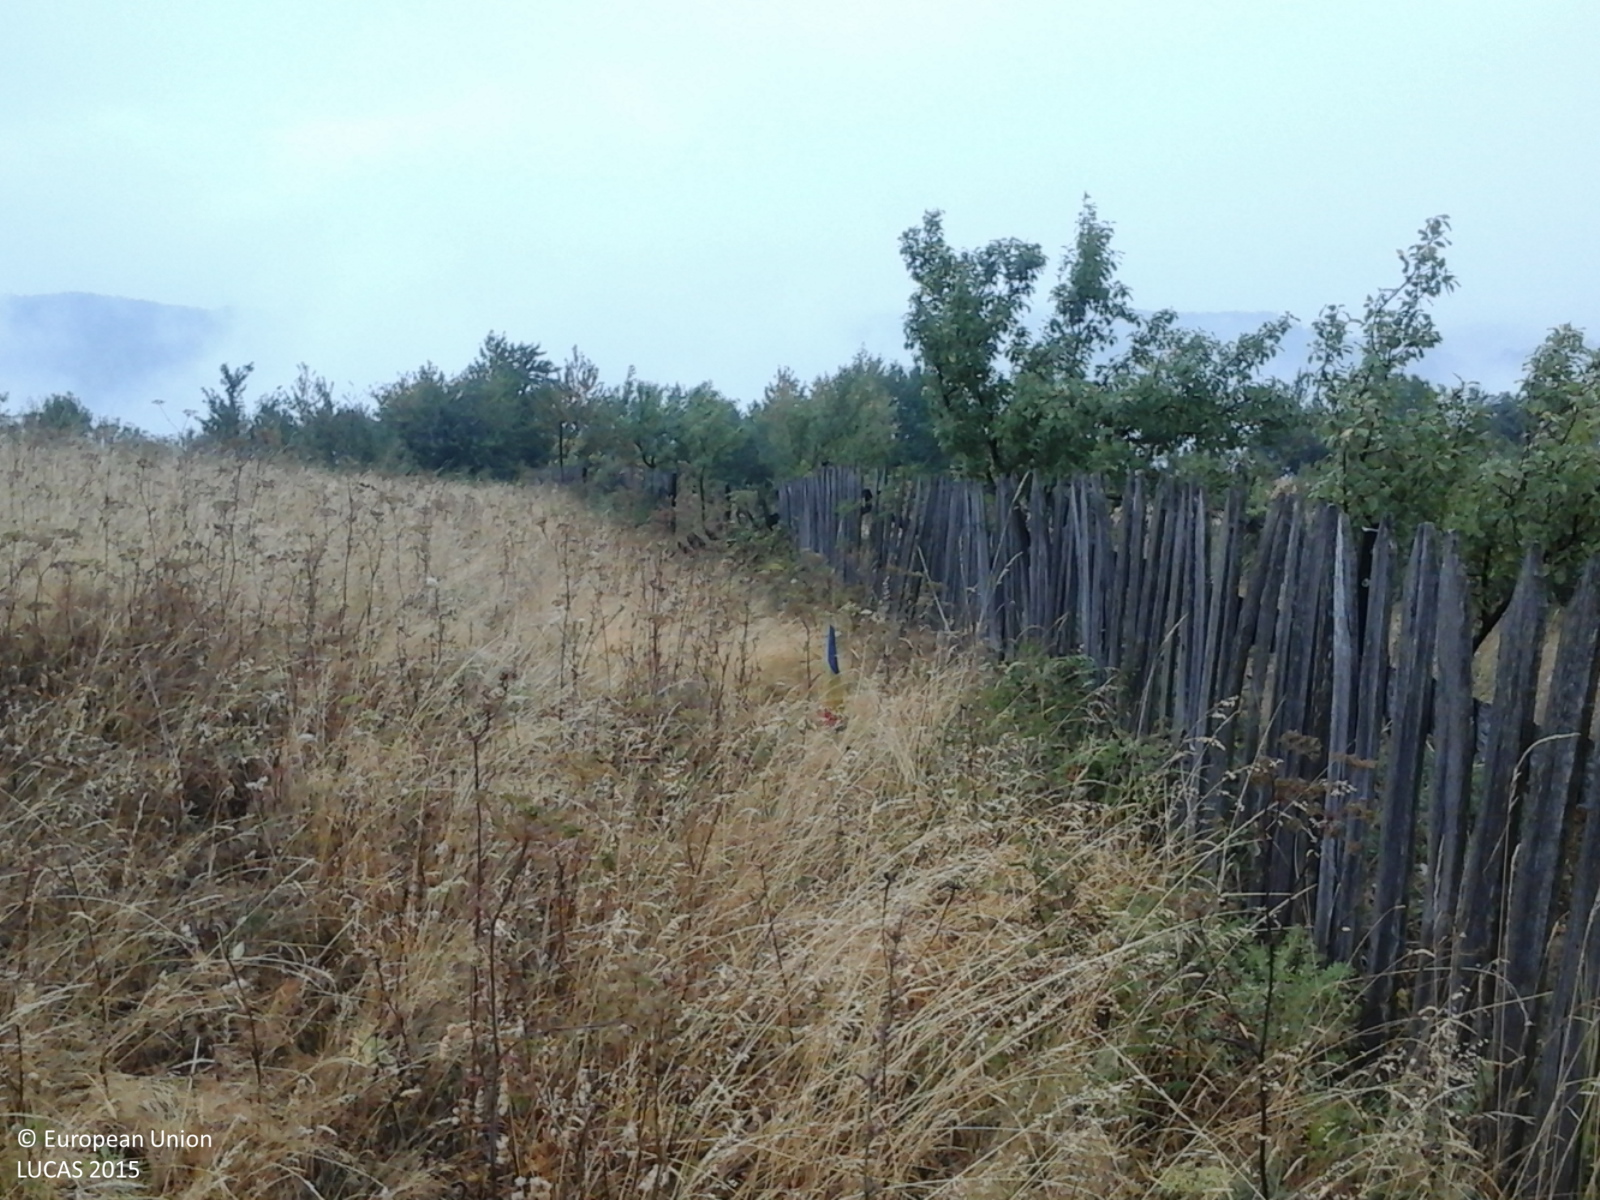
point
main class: Grassland
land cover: Spontaneously vegetated surfaces
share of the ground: > 75 %
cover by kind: herbaceous plants 100 %
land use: Fallow land
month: August
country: RO
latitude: 44.5620
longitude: 22.1587
